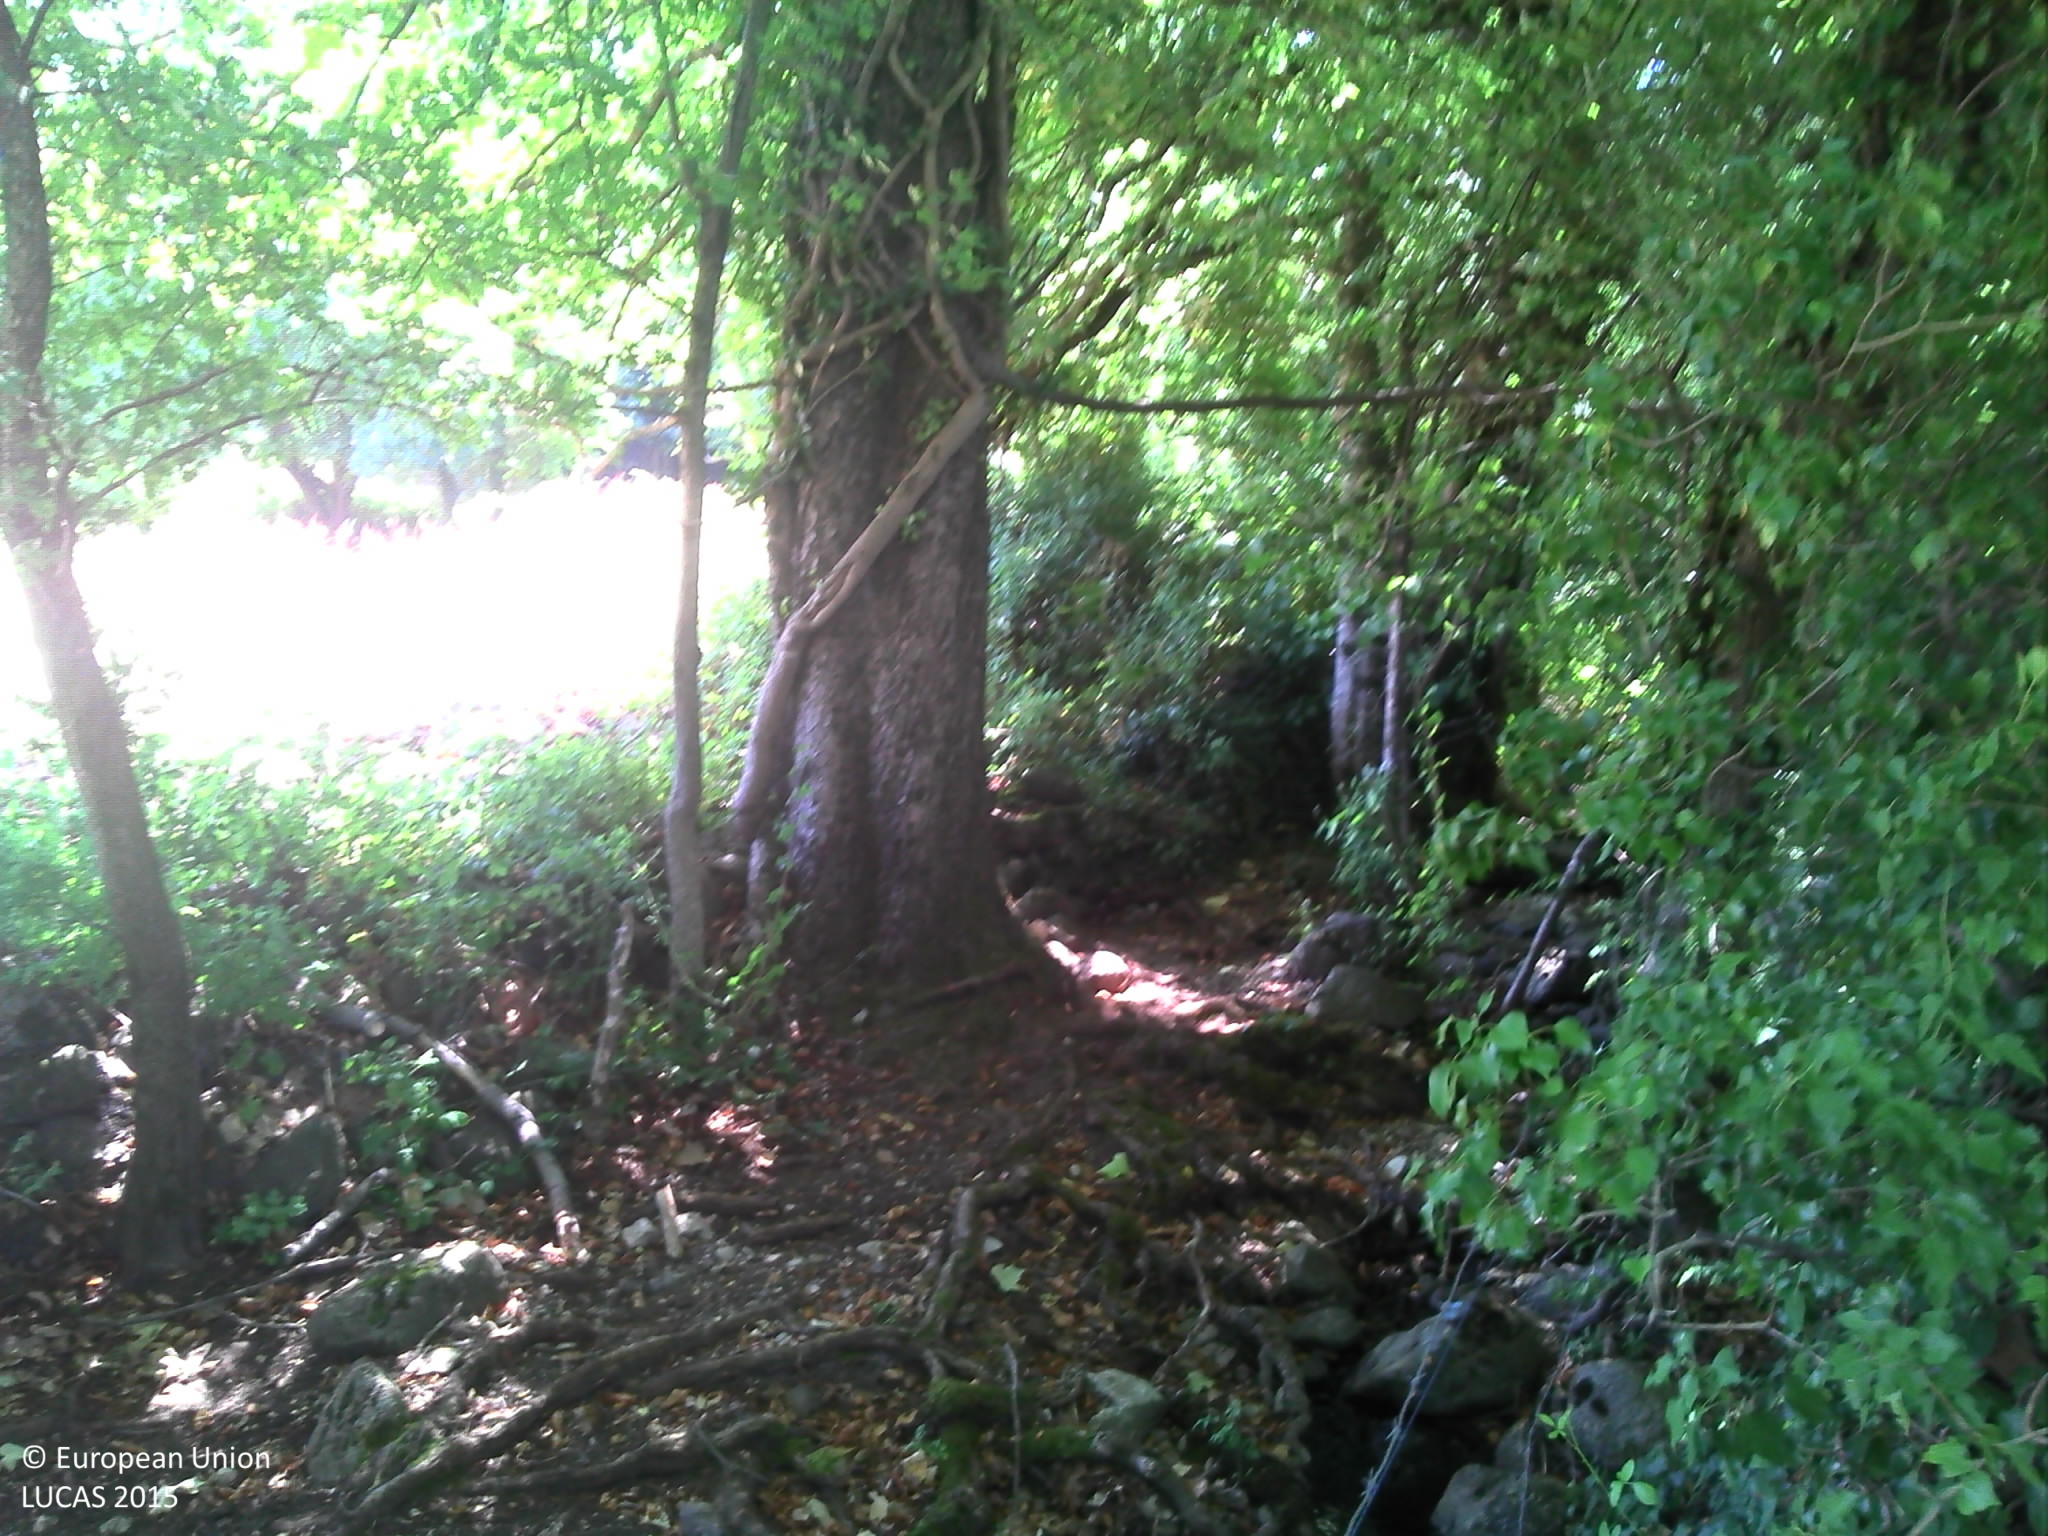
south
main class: Grassland
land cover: Grassland without tree/shrub cover
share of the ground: > 75 %
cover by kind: herbaceous plants 100 %
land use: Agriculture (excluding fallow land and kitchen gardens)
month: July
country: FR
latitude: 44.7154
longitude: 4.5906
